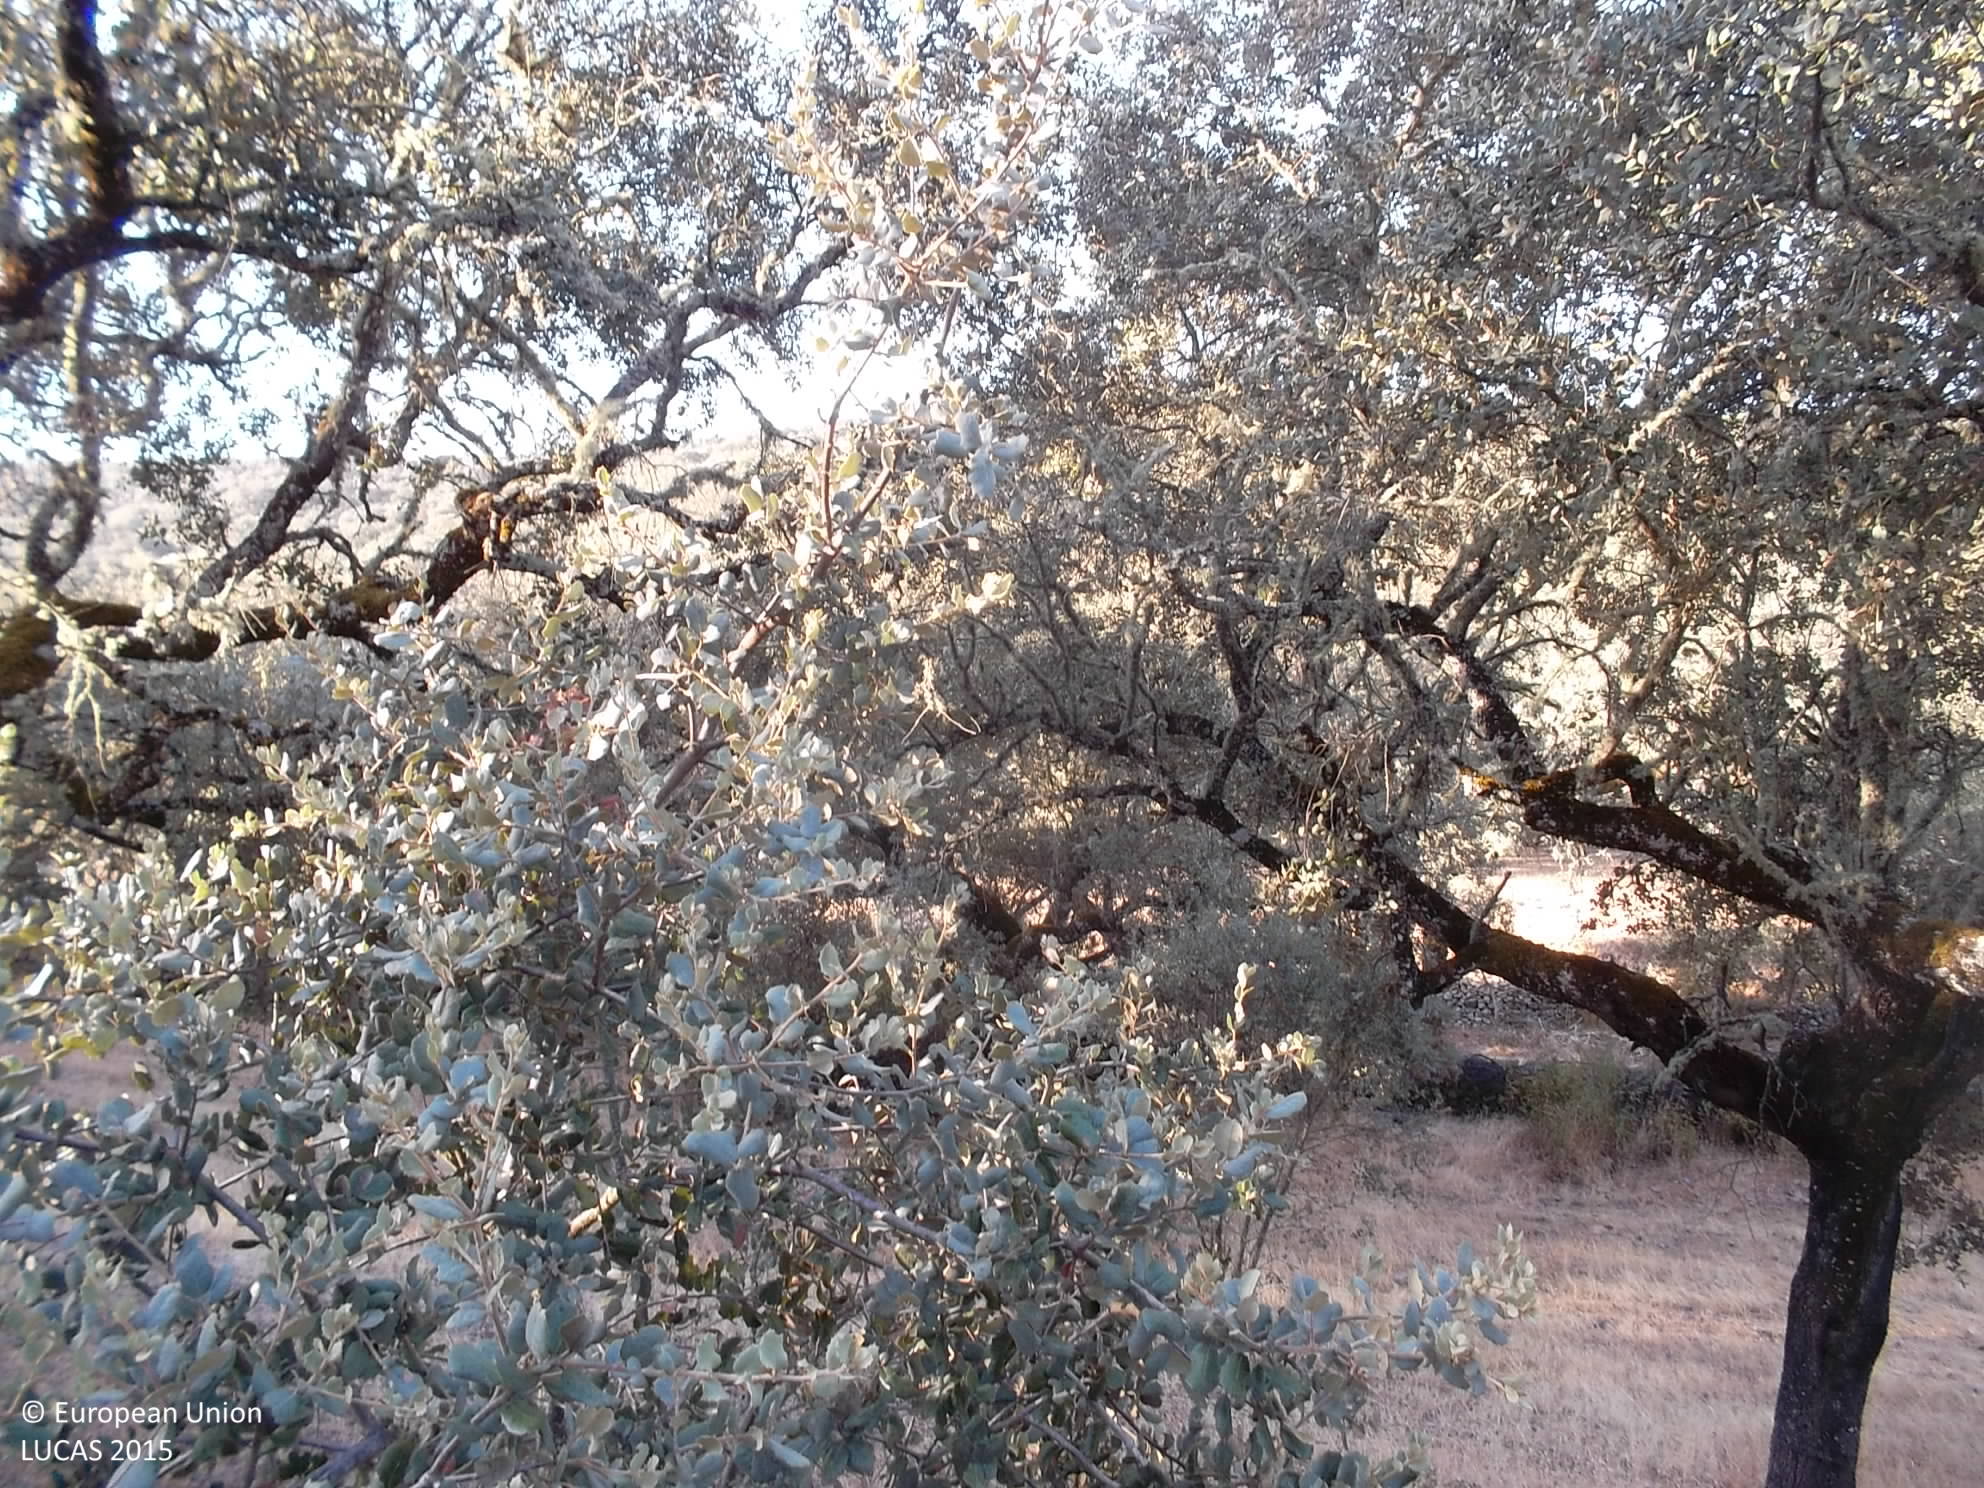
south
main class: Woodland
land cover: Broadleaved woodland
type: broadleaved evergreen forest
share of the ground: 50 - 75 %
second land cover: Grassland without tree/shrub cover
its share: > 75 %
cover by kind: broadleaved forest trees 50 %, herbaceous plants 50 %
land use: Forestry
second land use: Agriculture (excluding fallow land and kitchen gardens)
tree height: < 5 m
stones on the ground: 10 - 25 %
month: August
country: ES
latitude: 38.1151
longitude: -6.6446
